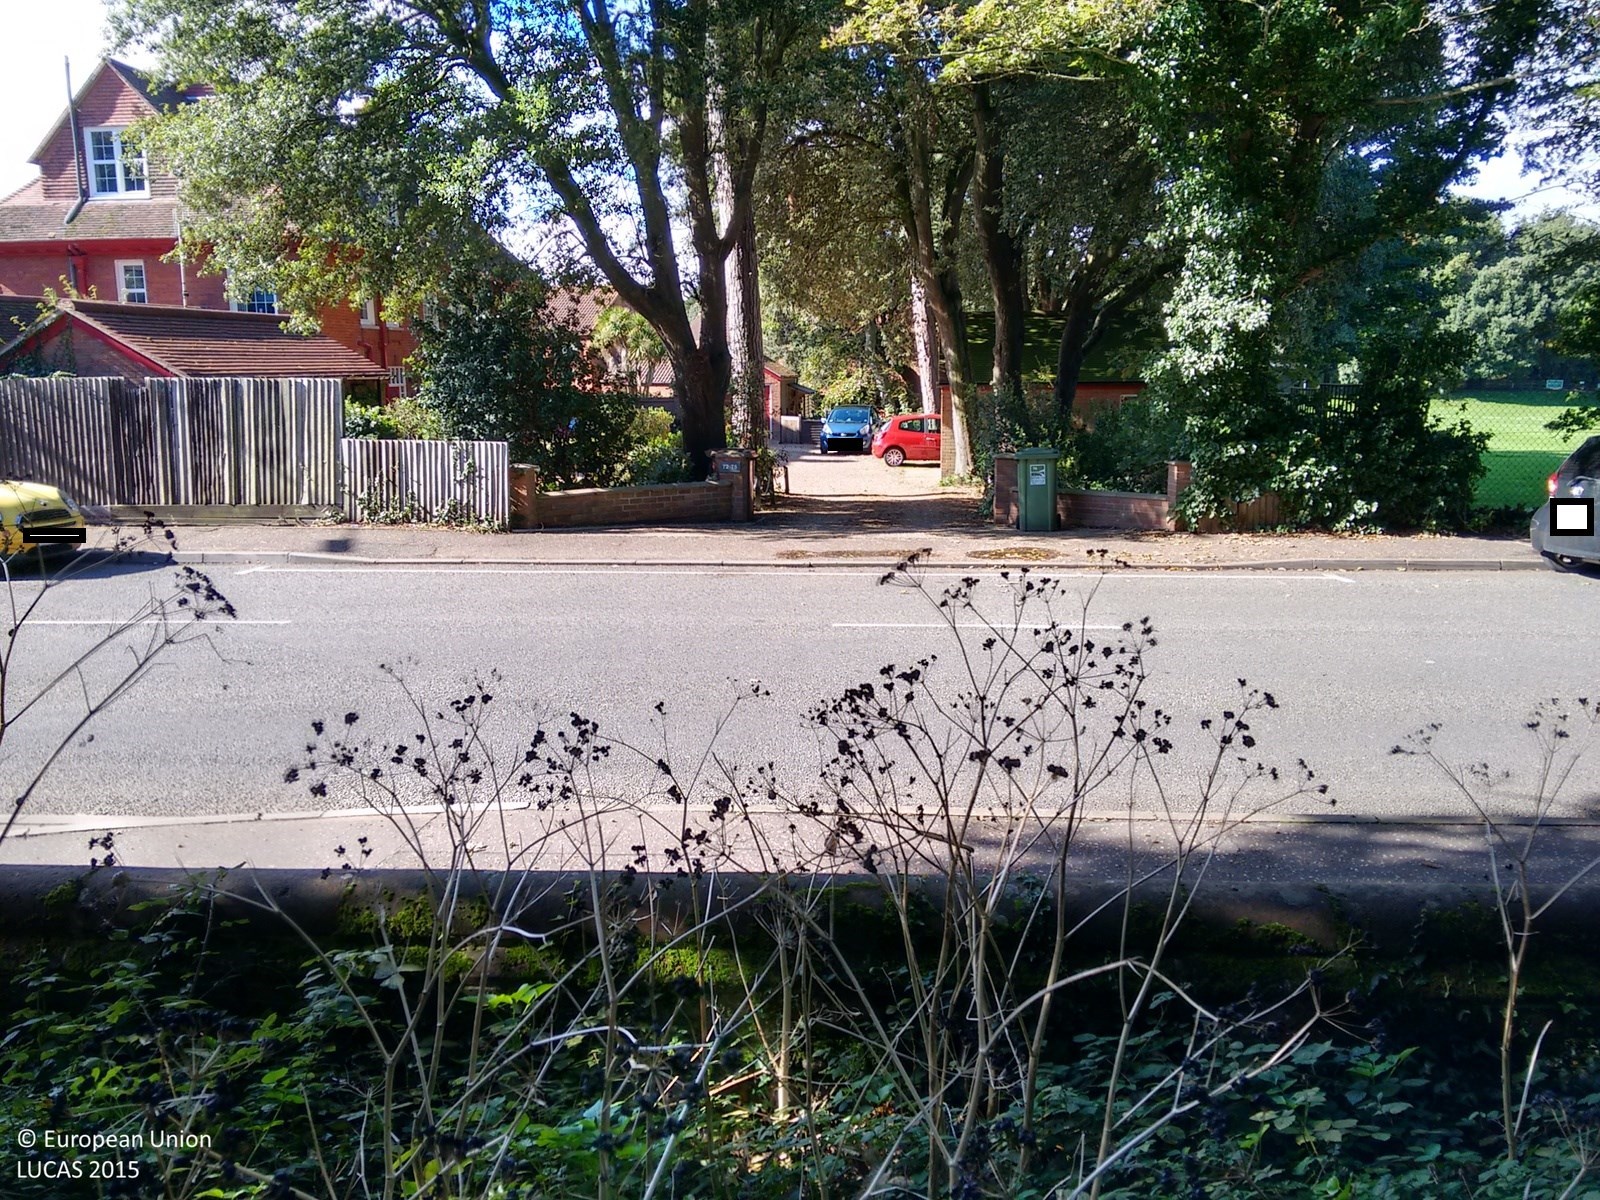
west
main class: Woodland
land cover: Broadleaved woodland
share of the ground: > 75 %
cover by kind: broadleaved forest trees 100 %
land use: Residential
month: September
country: GB
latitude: 52.9262
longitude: 1.3075
